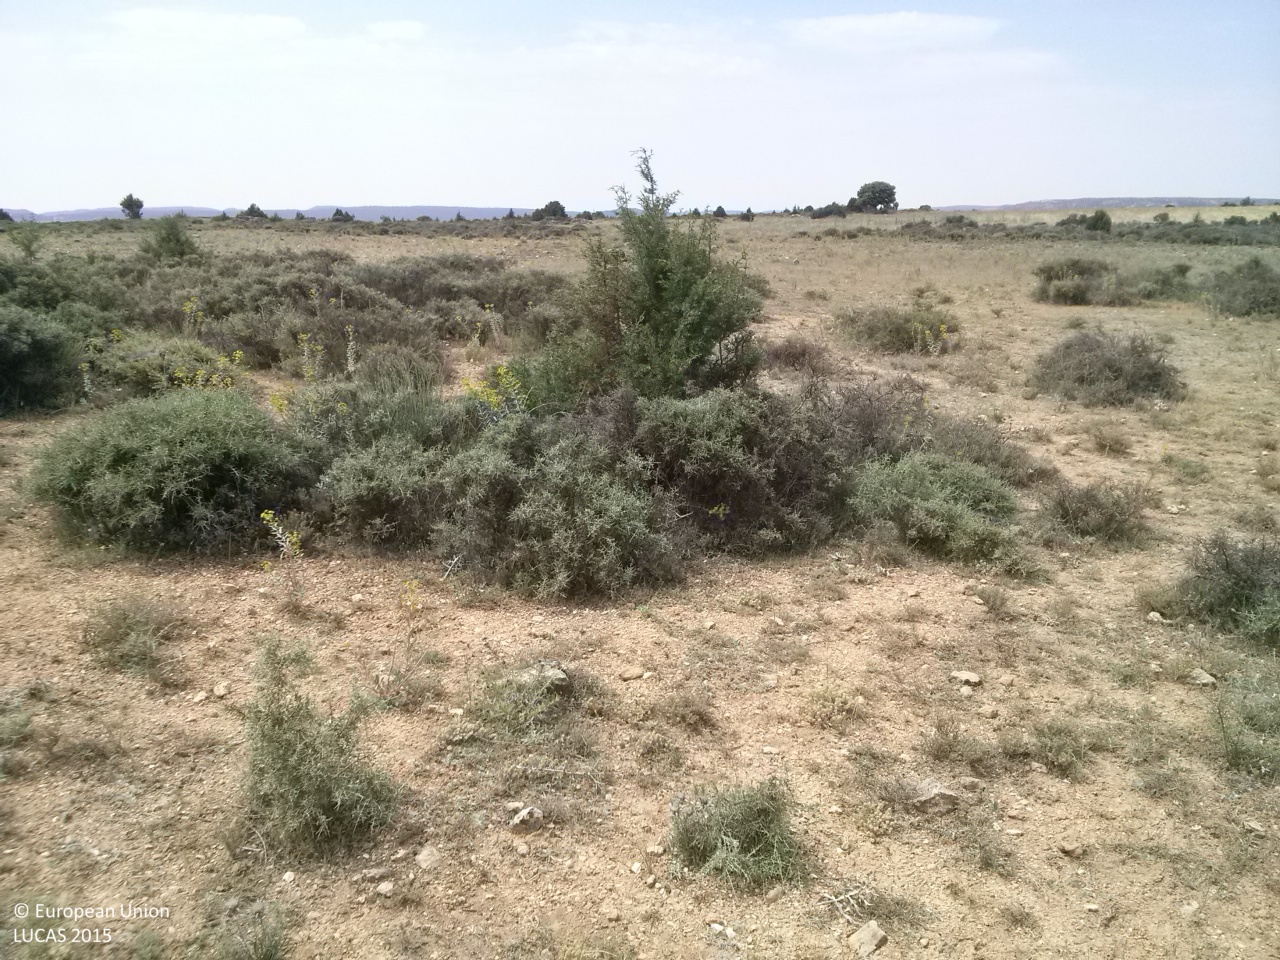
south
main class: Shrubland
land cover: Shrubland without tree cover
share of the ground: 25 - 50 %
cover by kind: shrubs 40 %, herbaceous plants 30 %, unconsolidated bare surface 30 %
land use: Agriculture (excluding fallow land and kitchen gardens)
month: June
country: ES
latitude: 39.9517
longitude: -1.8221
